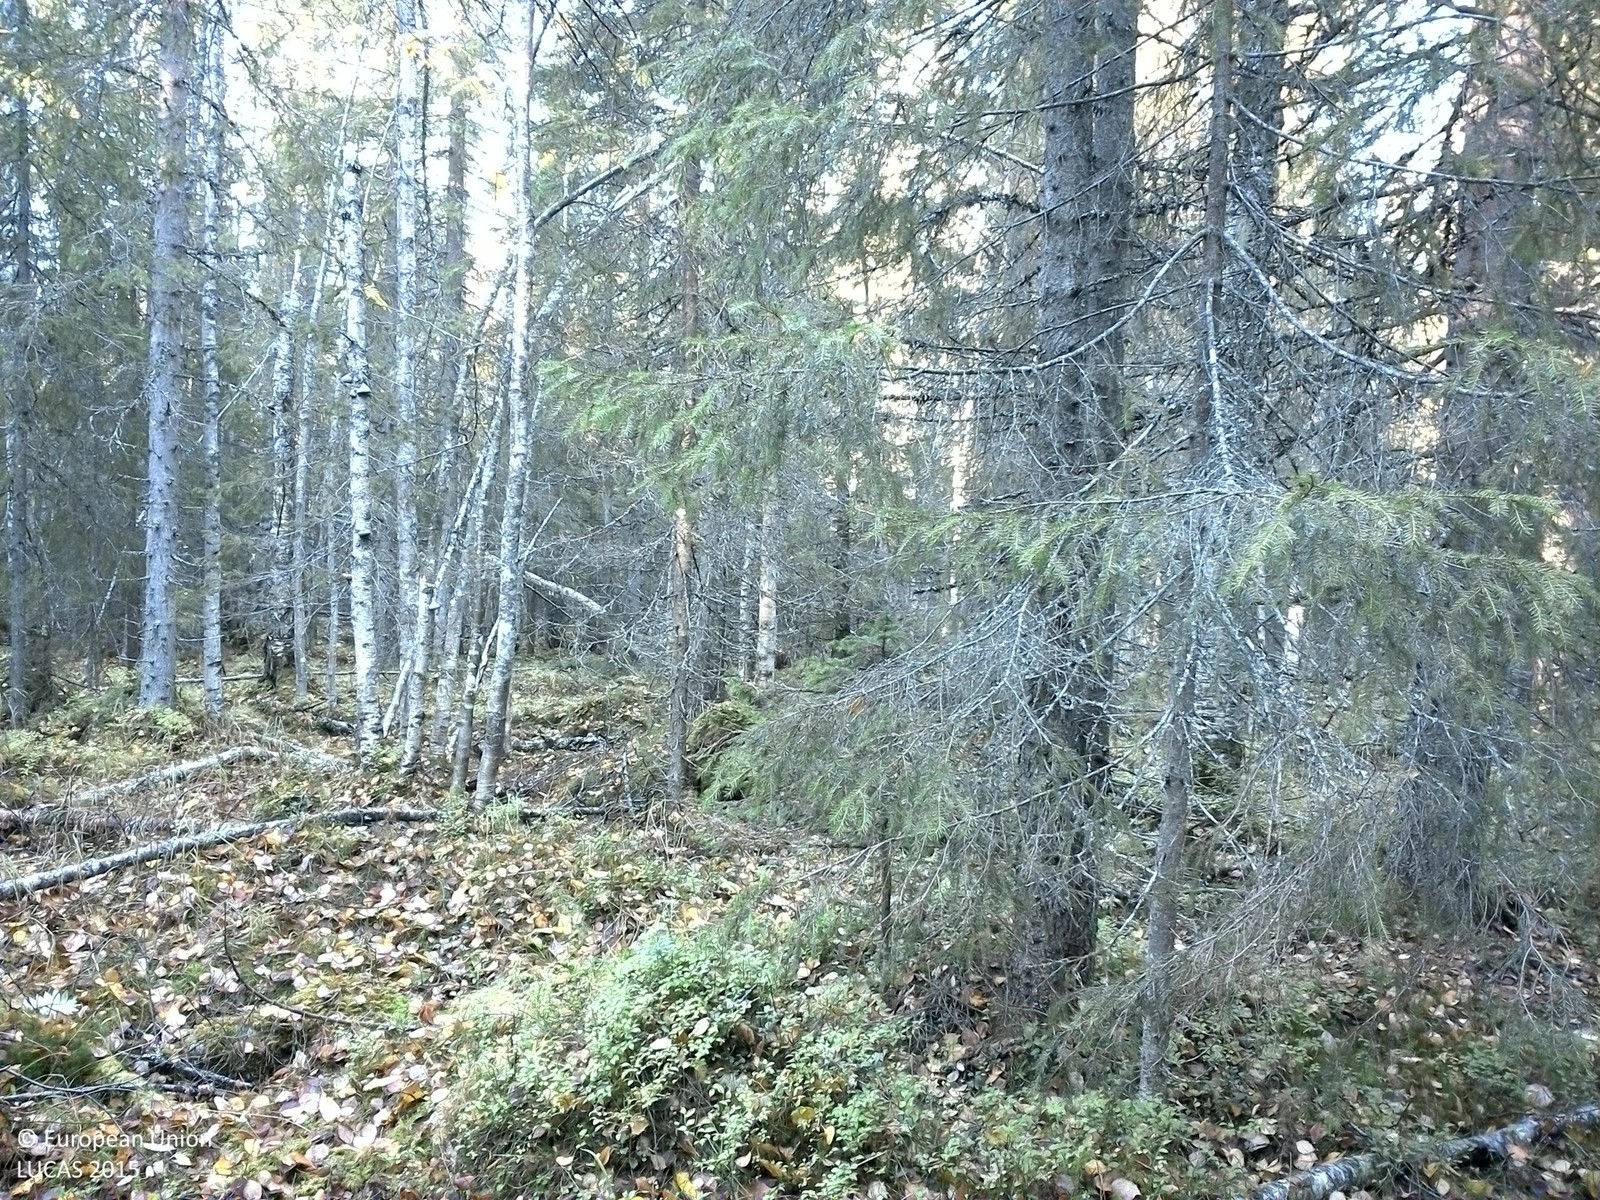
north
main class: Woodland
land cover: Spruce dominated mixed woodland
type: boreal forest
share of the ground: 50 - 75 %
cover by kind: coniferous forest trees 40 %, broadleaved forest trees 20 %, shrubs 20 %, lichens and mosses 15 %, herbaceous plants 5 %
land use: Forestry
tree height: > 5 m
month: October
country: SE
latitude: 64.5757
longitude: 15.4603
